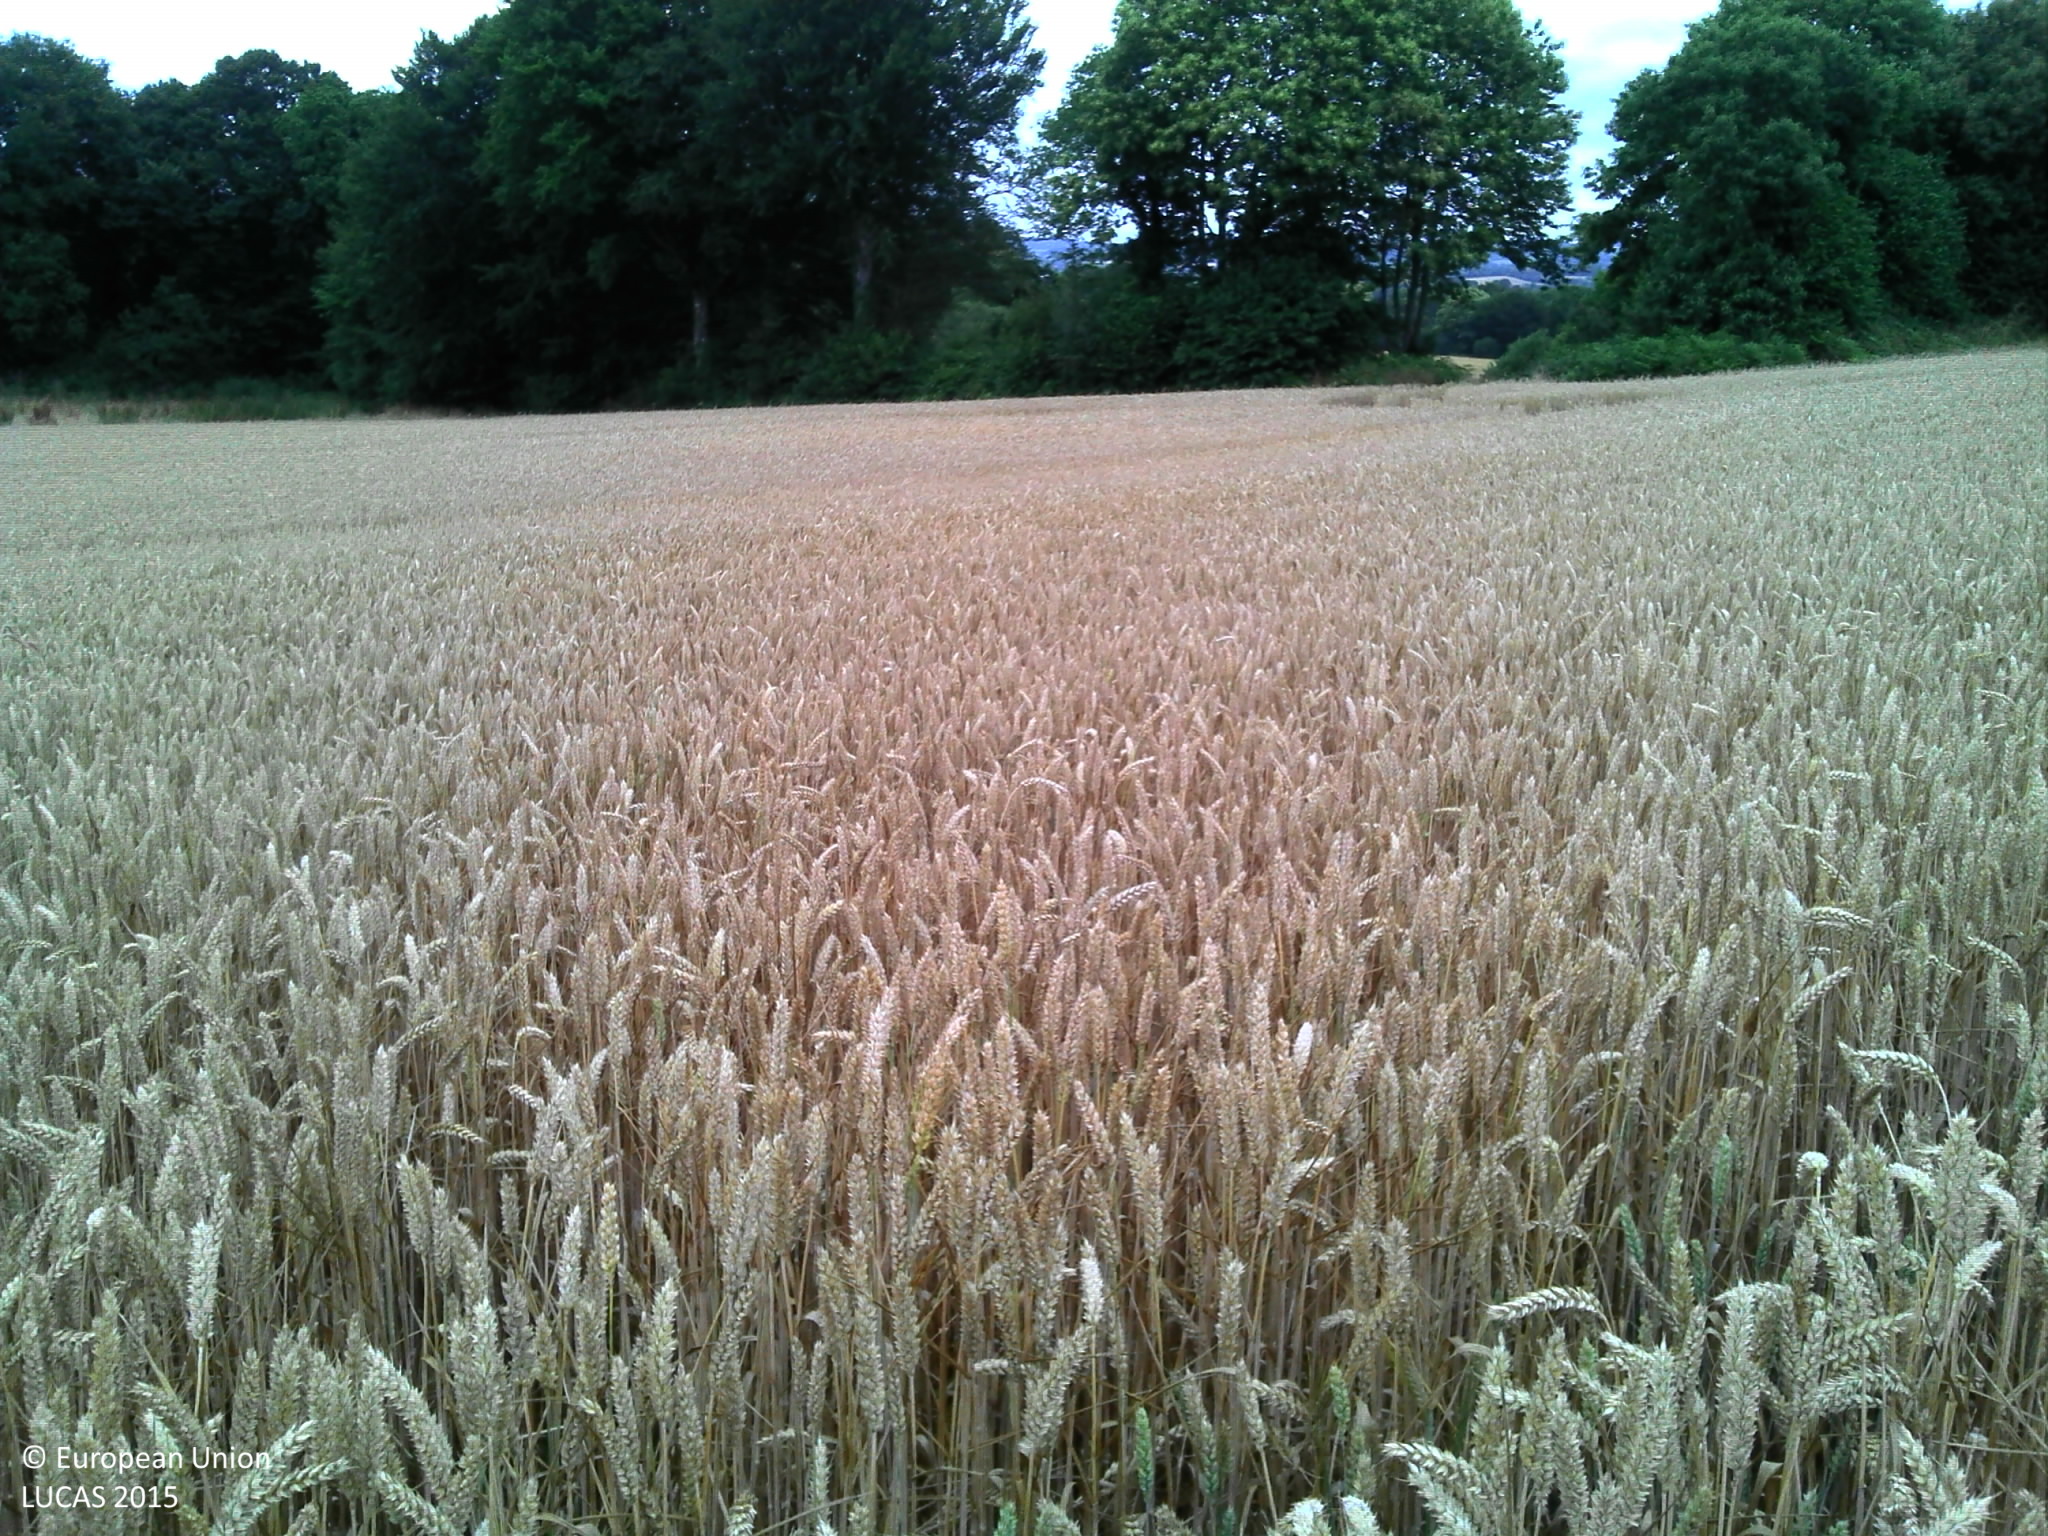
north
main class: Cropland
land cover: Common wheat
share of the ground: > 75 %
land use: Agriculture (excluding fallow land and kitchen gardens)
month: July
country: FR
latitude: 48.1262
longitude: -3.5813
